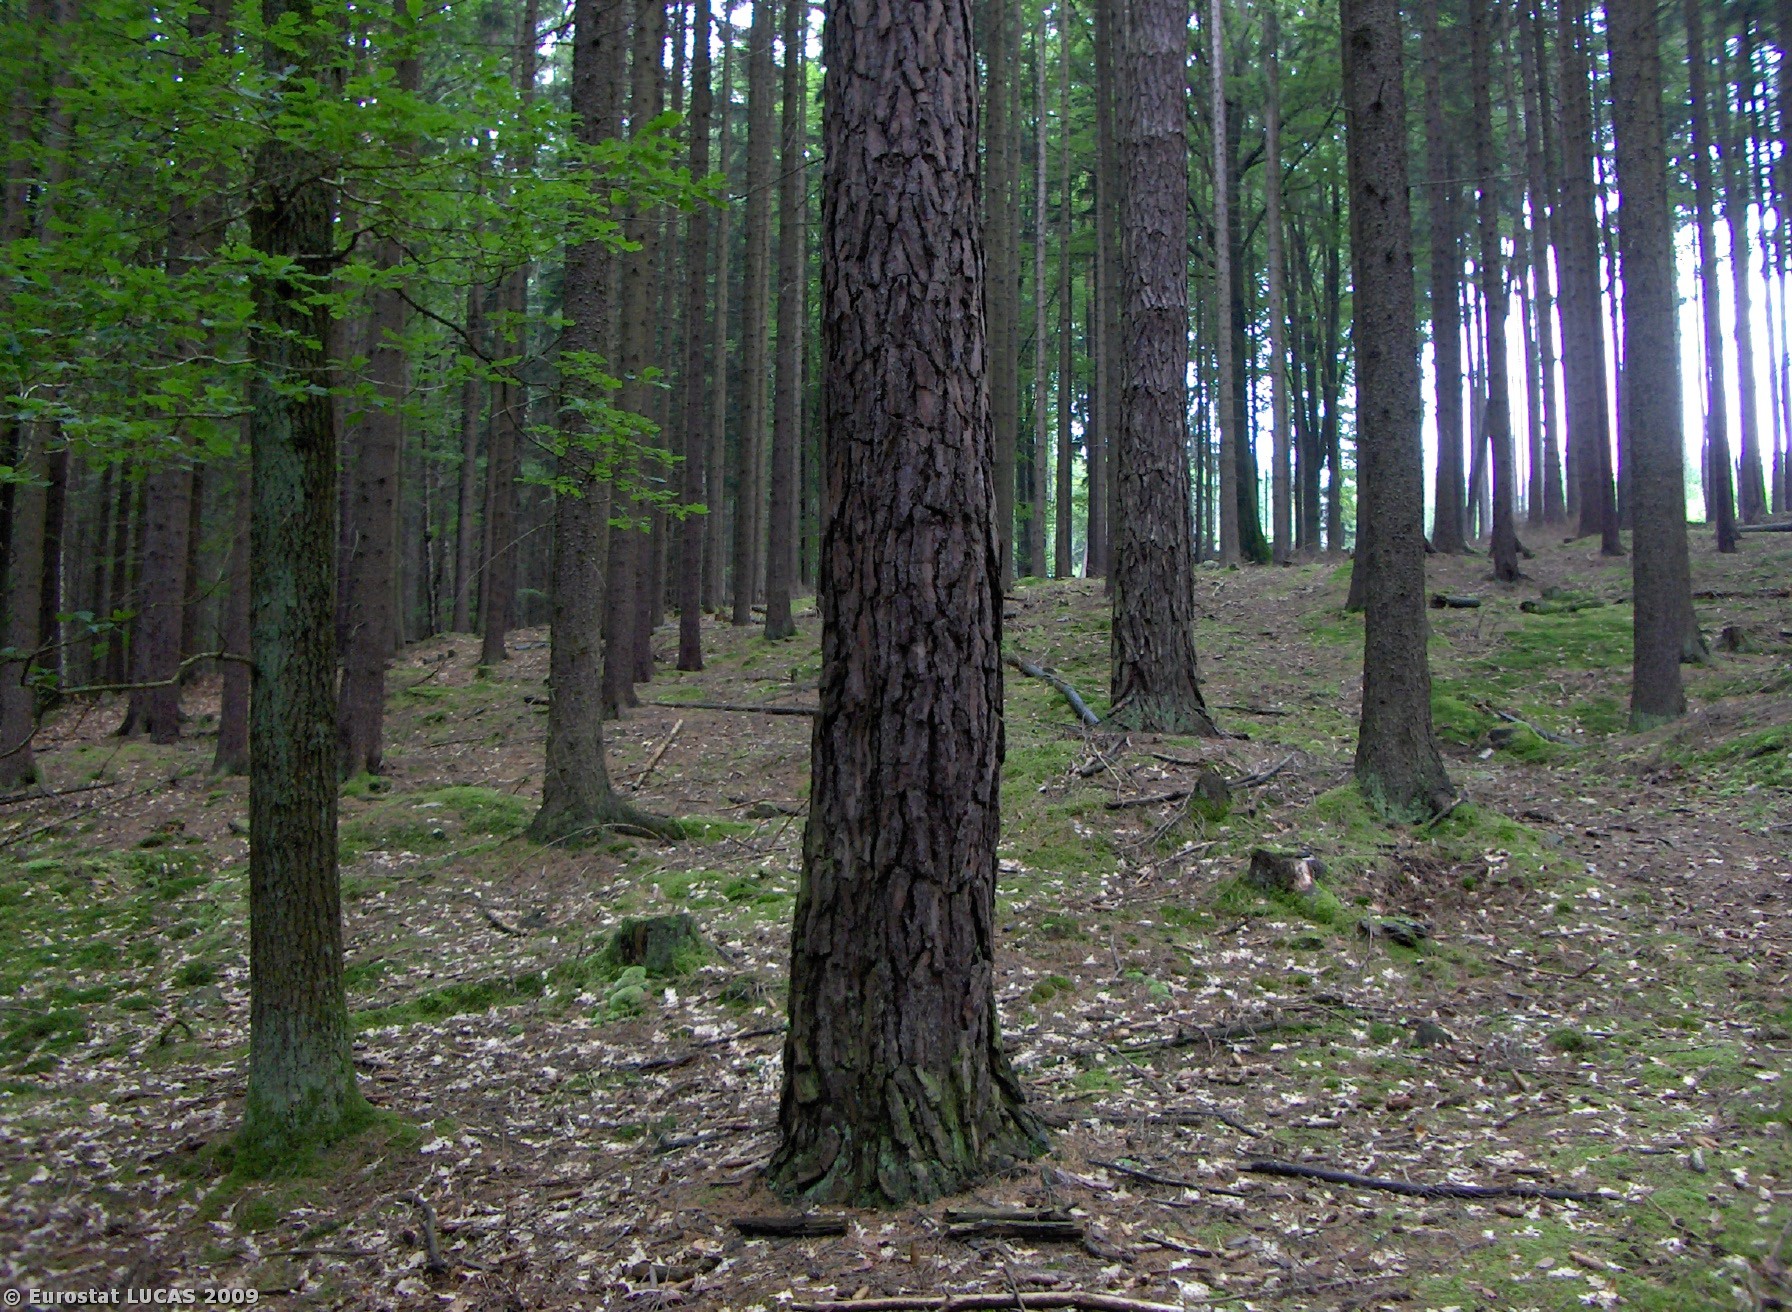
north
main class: Woodland
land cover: Coniferous woodland
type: hemiboreal forest and nemoral coniferous forest and mixed broadleaved-coniferous forest
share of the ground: > 75 %
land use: Forestry
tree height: > 5 m
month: July
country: CZ
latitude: 49.3562
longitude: 12.8771
